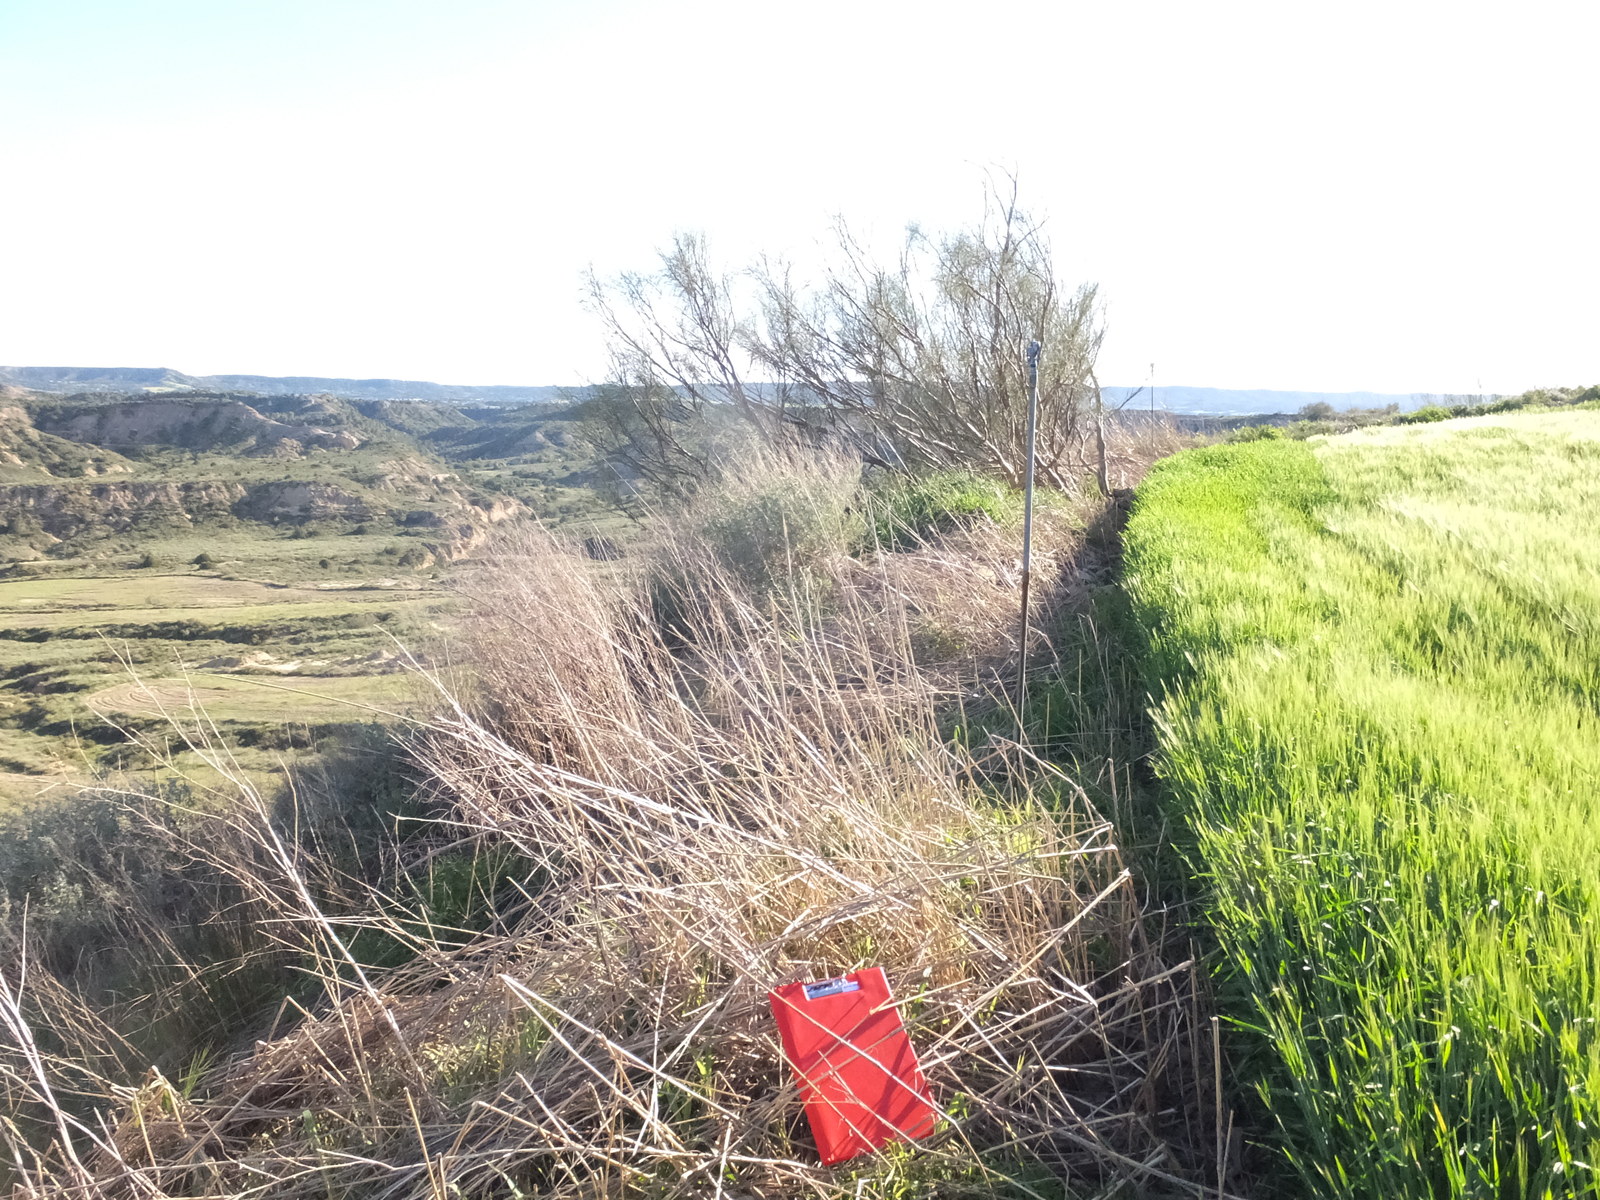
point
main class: Grassland
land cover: Grassland with sparse tree/shrub cover
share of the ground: > 75 %
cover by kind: herbaceous plants 90 %, coniferous forest trees 5 %, shrubs 5 %
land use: Semi-natural and natural areas not in use
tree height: < 5 m
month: April
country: ES
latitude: 41.7016
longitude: -0.1957
